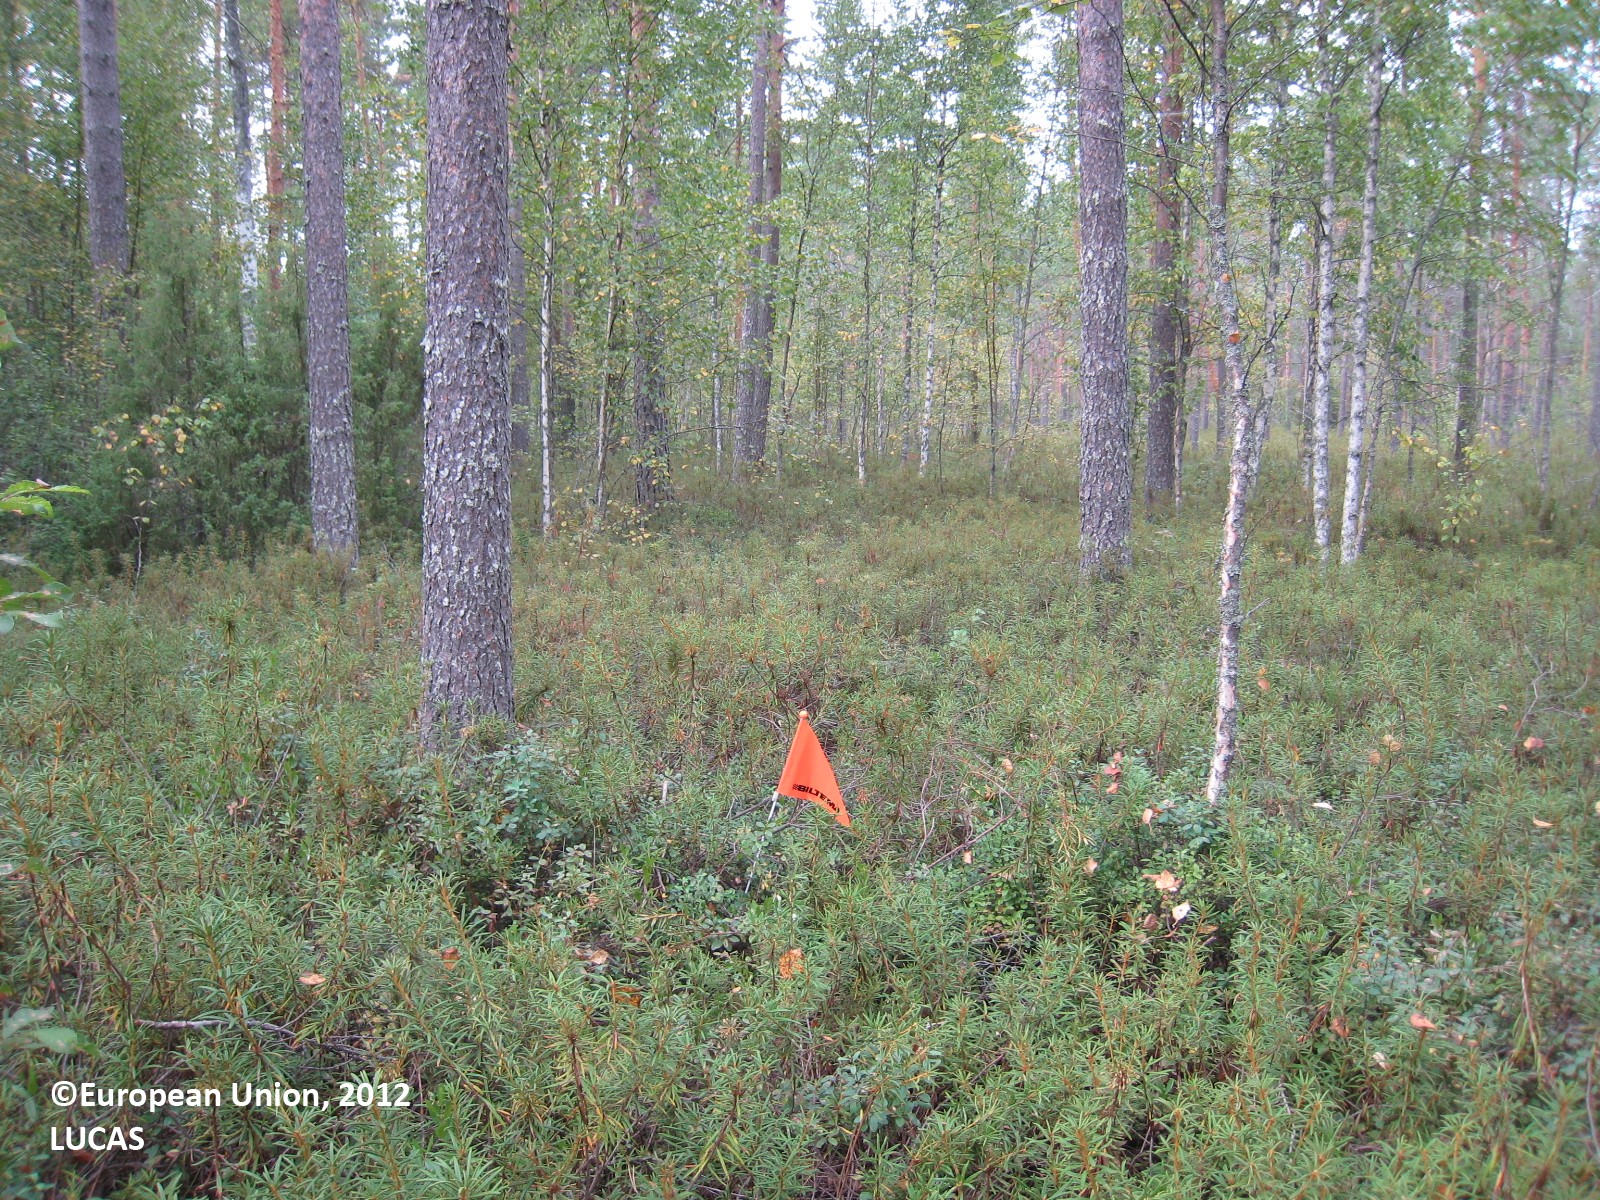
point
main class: Woodland
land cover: Pine dominated mixed woodland
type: mire and swamp forests
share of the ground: 50 - 75 %
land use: Forestry
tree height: > 5 m
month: August
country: FI
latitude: 62.2068
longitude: 27.1736
